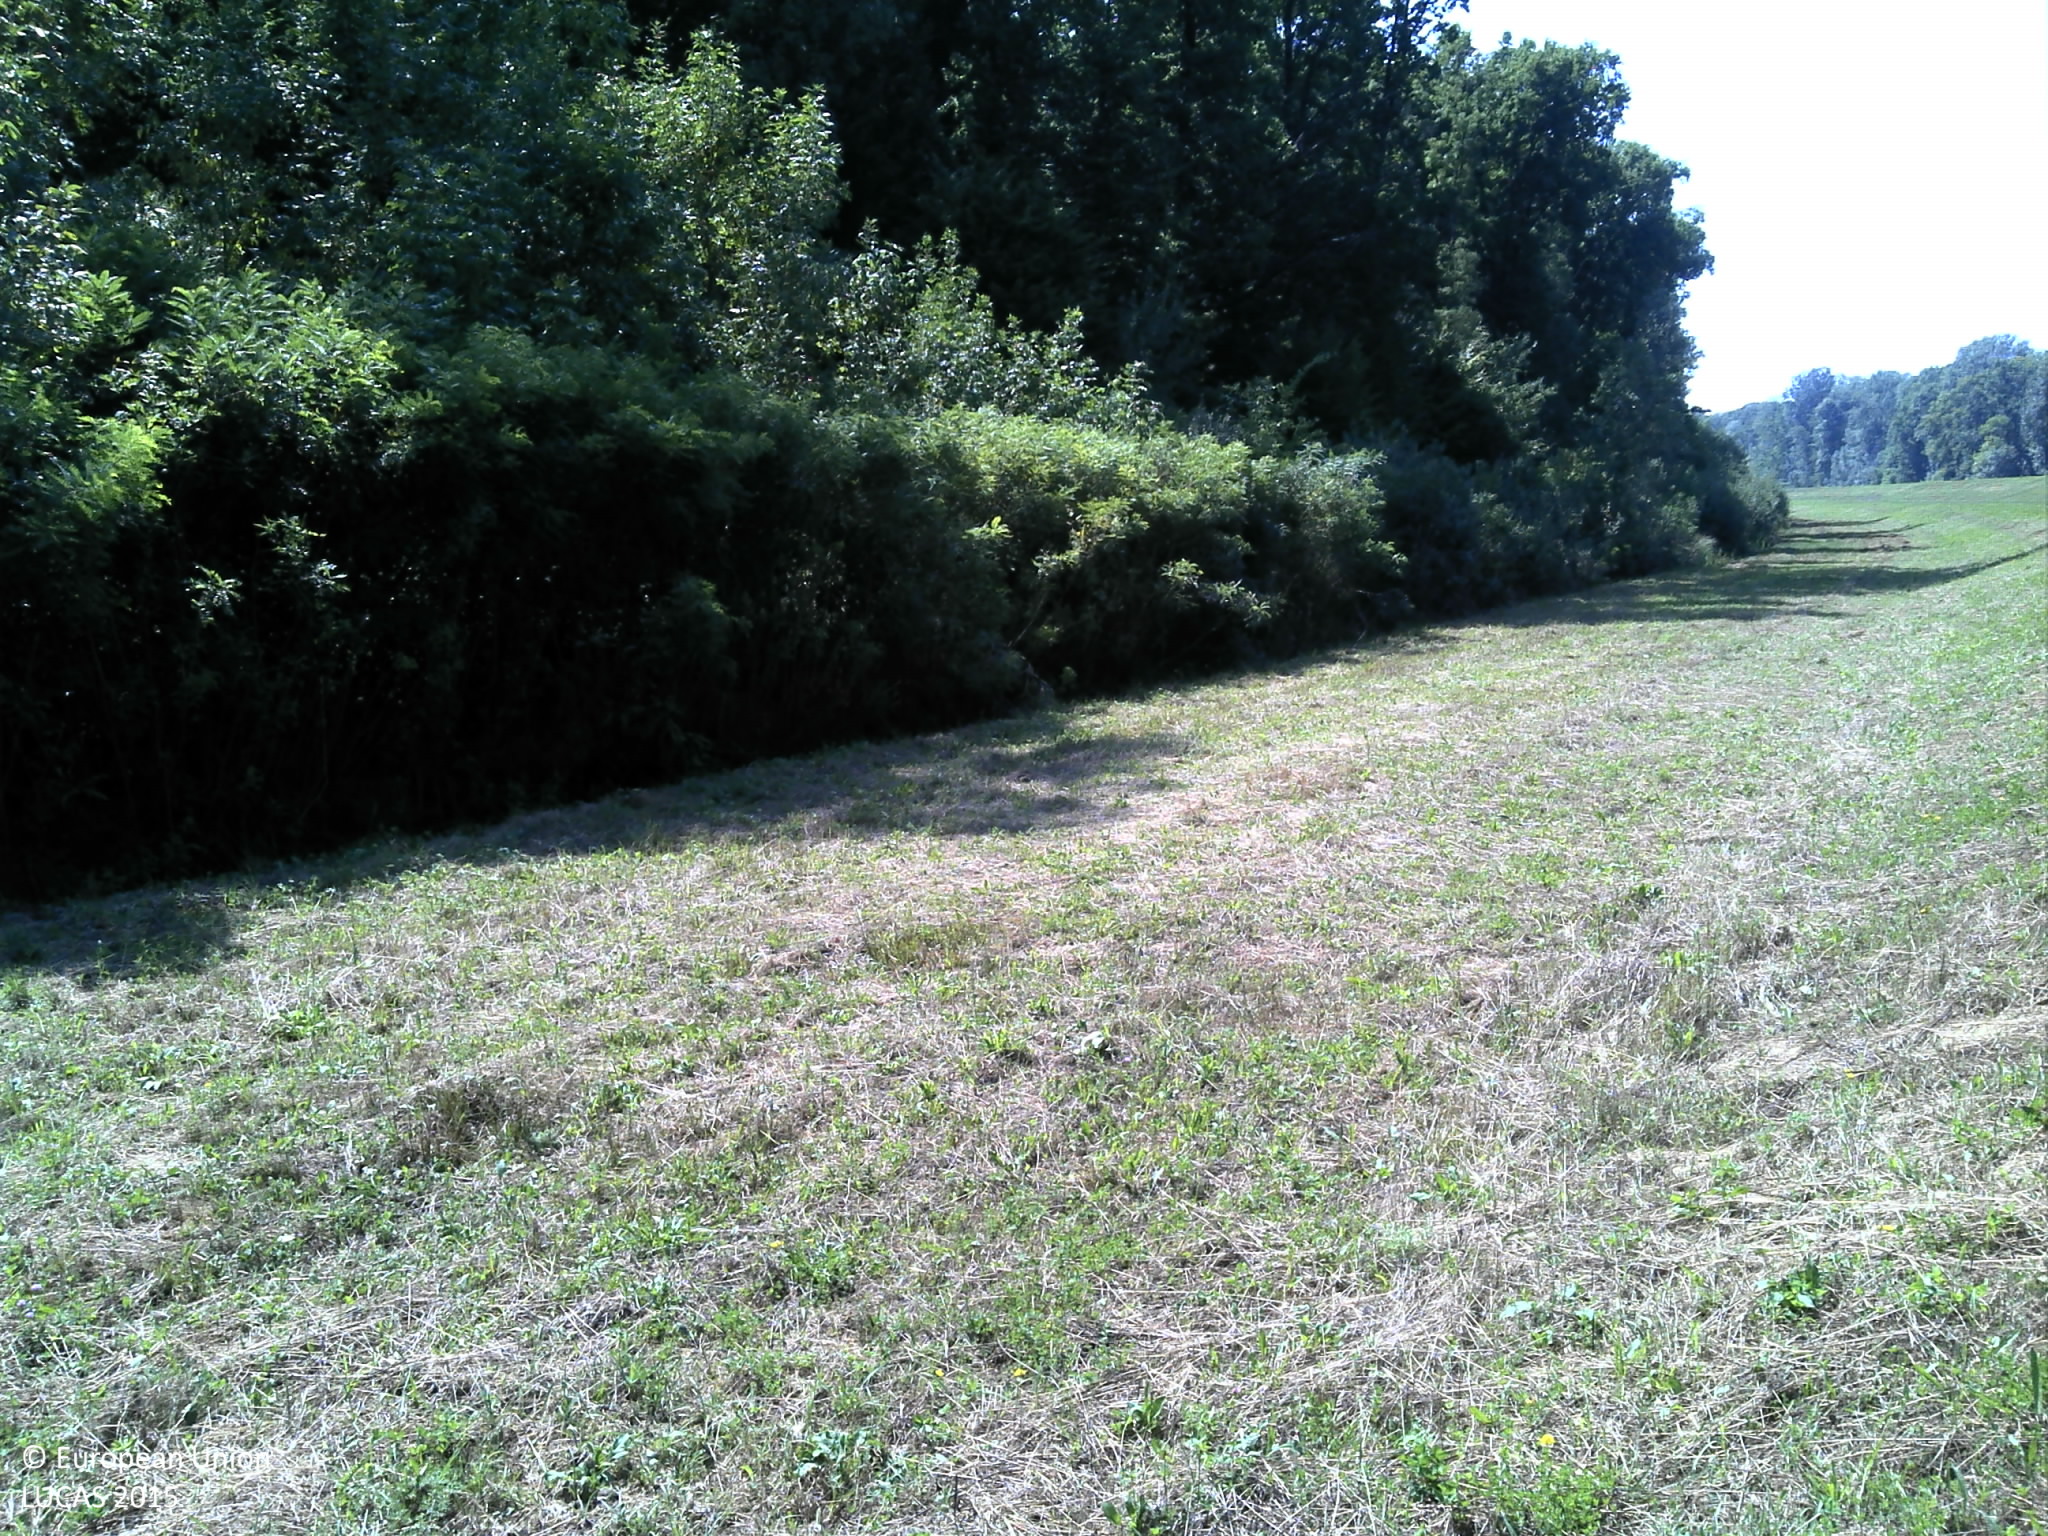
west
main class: Grassland
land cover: Grassland without tree/shrub cover
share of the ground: > 75 %
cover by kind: herbaceous plants 100 %
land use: Semi-natural and natural areas not in use
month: August
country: HR
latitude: 45.4810
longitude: 16.5613
